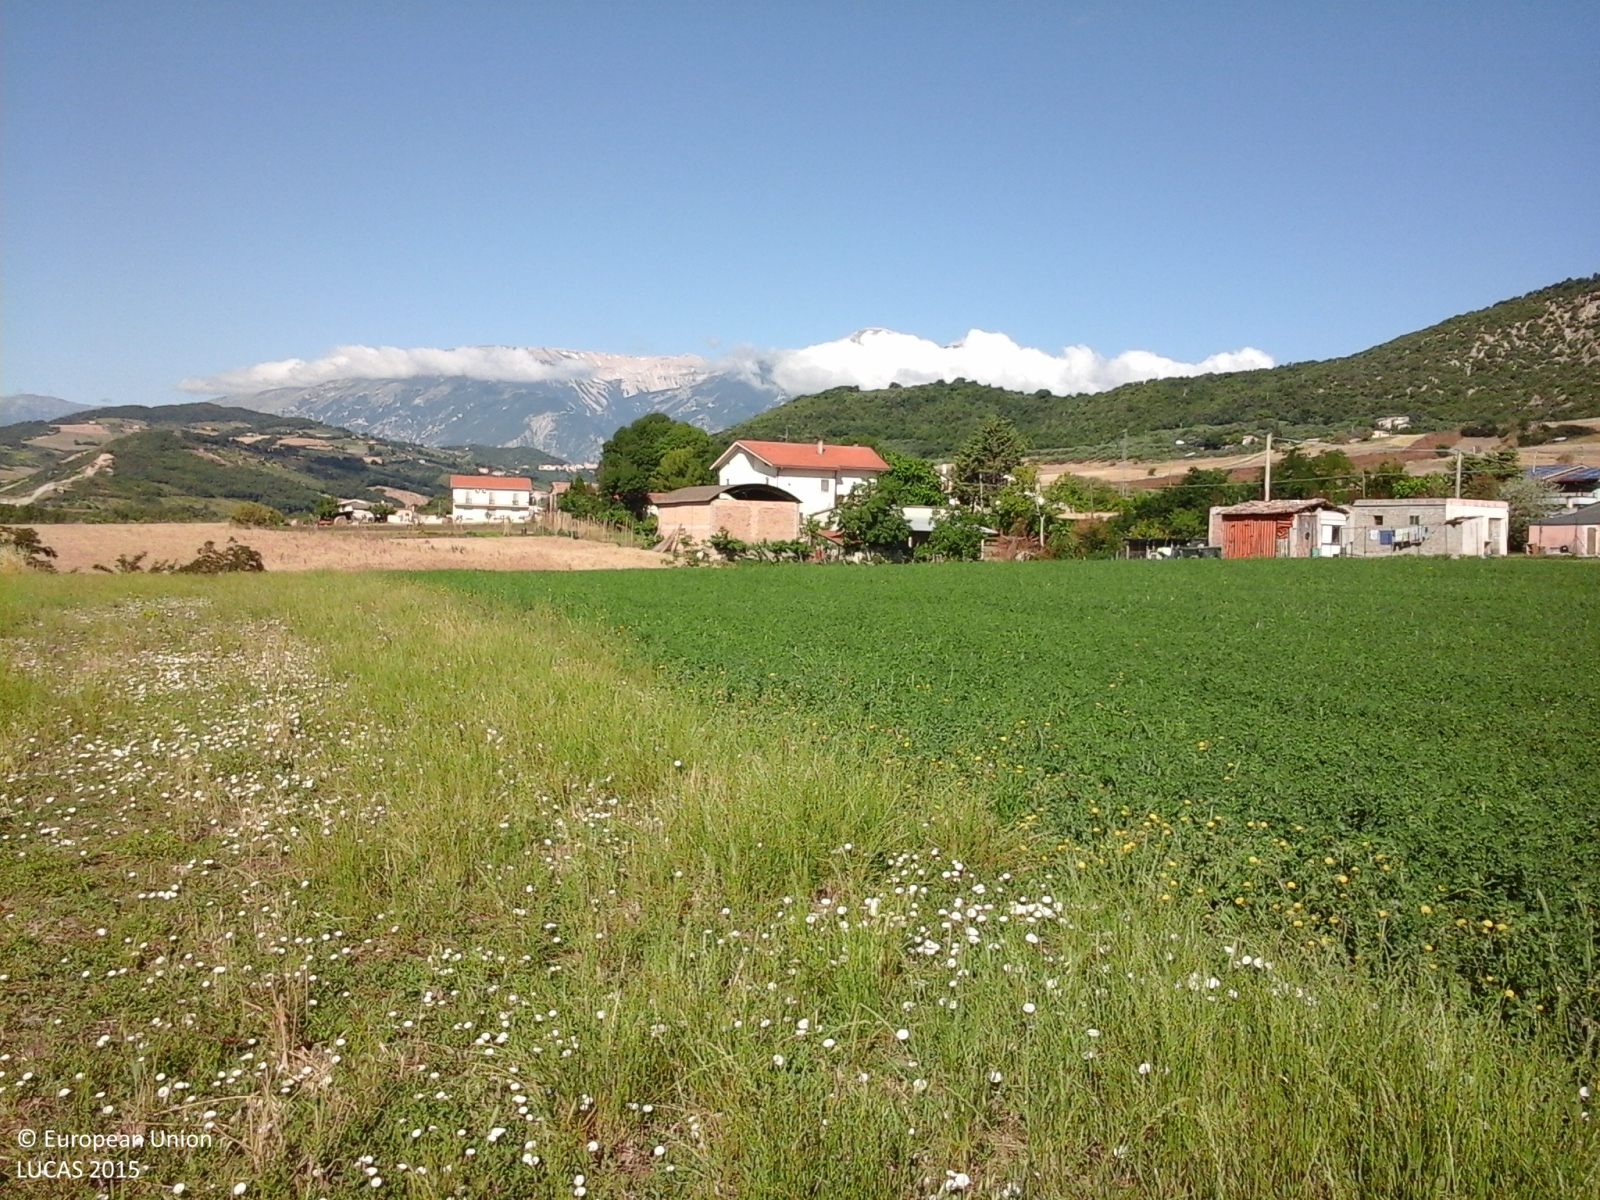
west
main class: Cropland
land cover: Other leguminous and mixtures for fodder
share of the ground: > 75 %
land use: Agriculture (excluding fallow land and kitchen gardens)
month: June
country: IT
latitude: 42.1264
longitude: 14.3532
